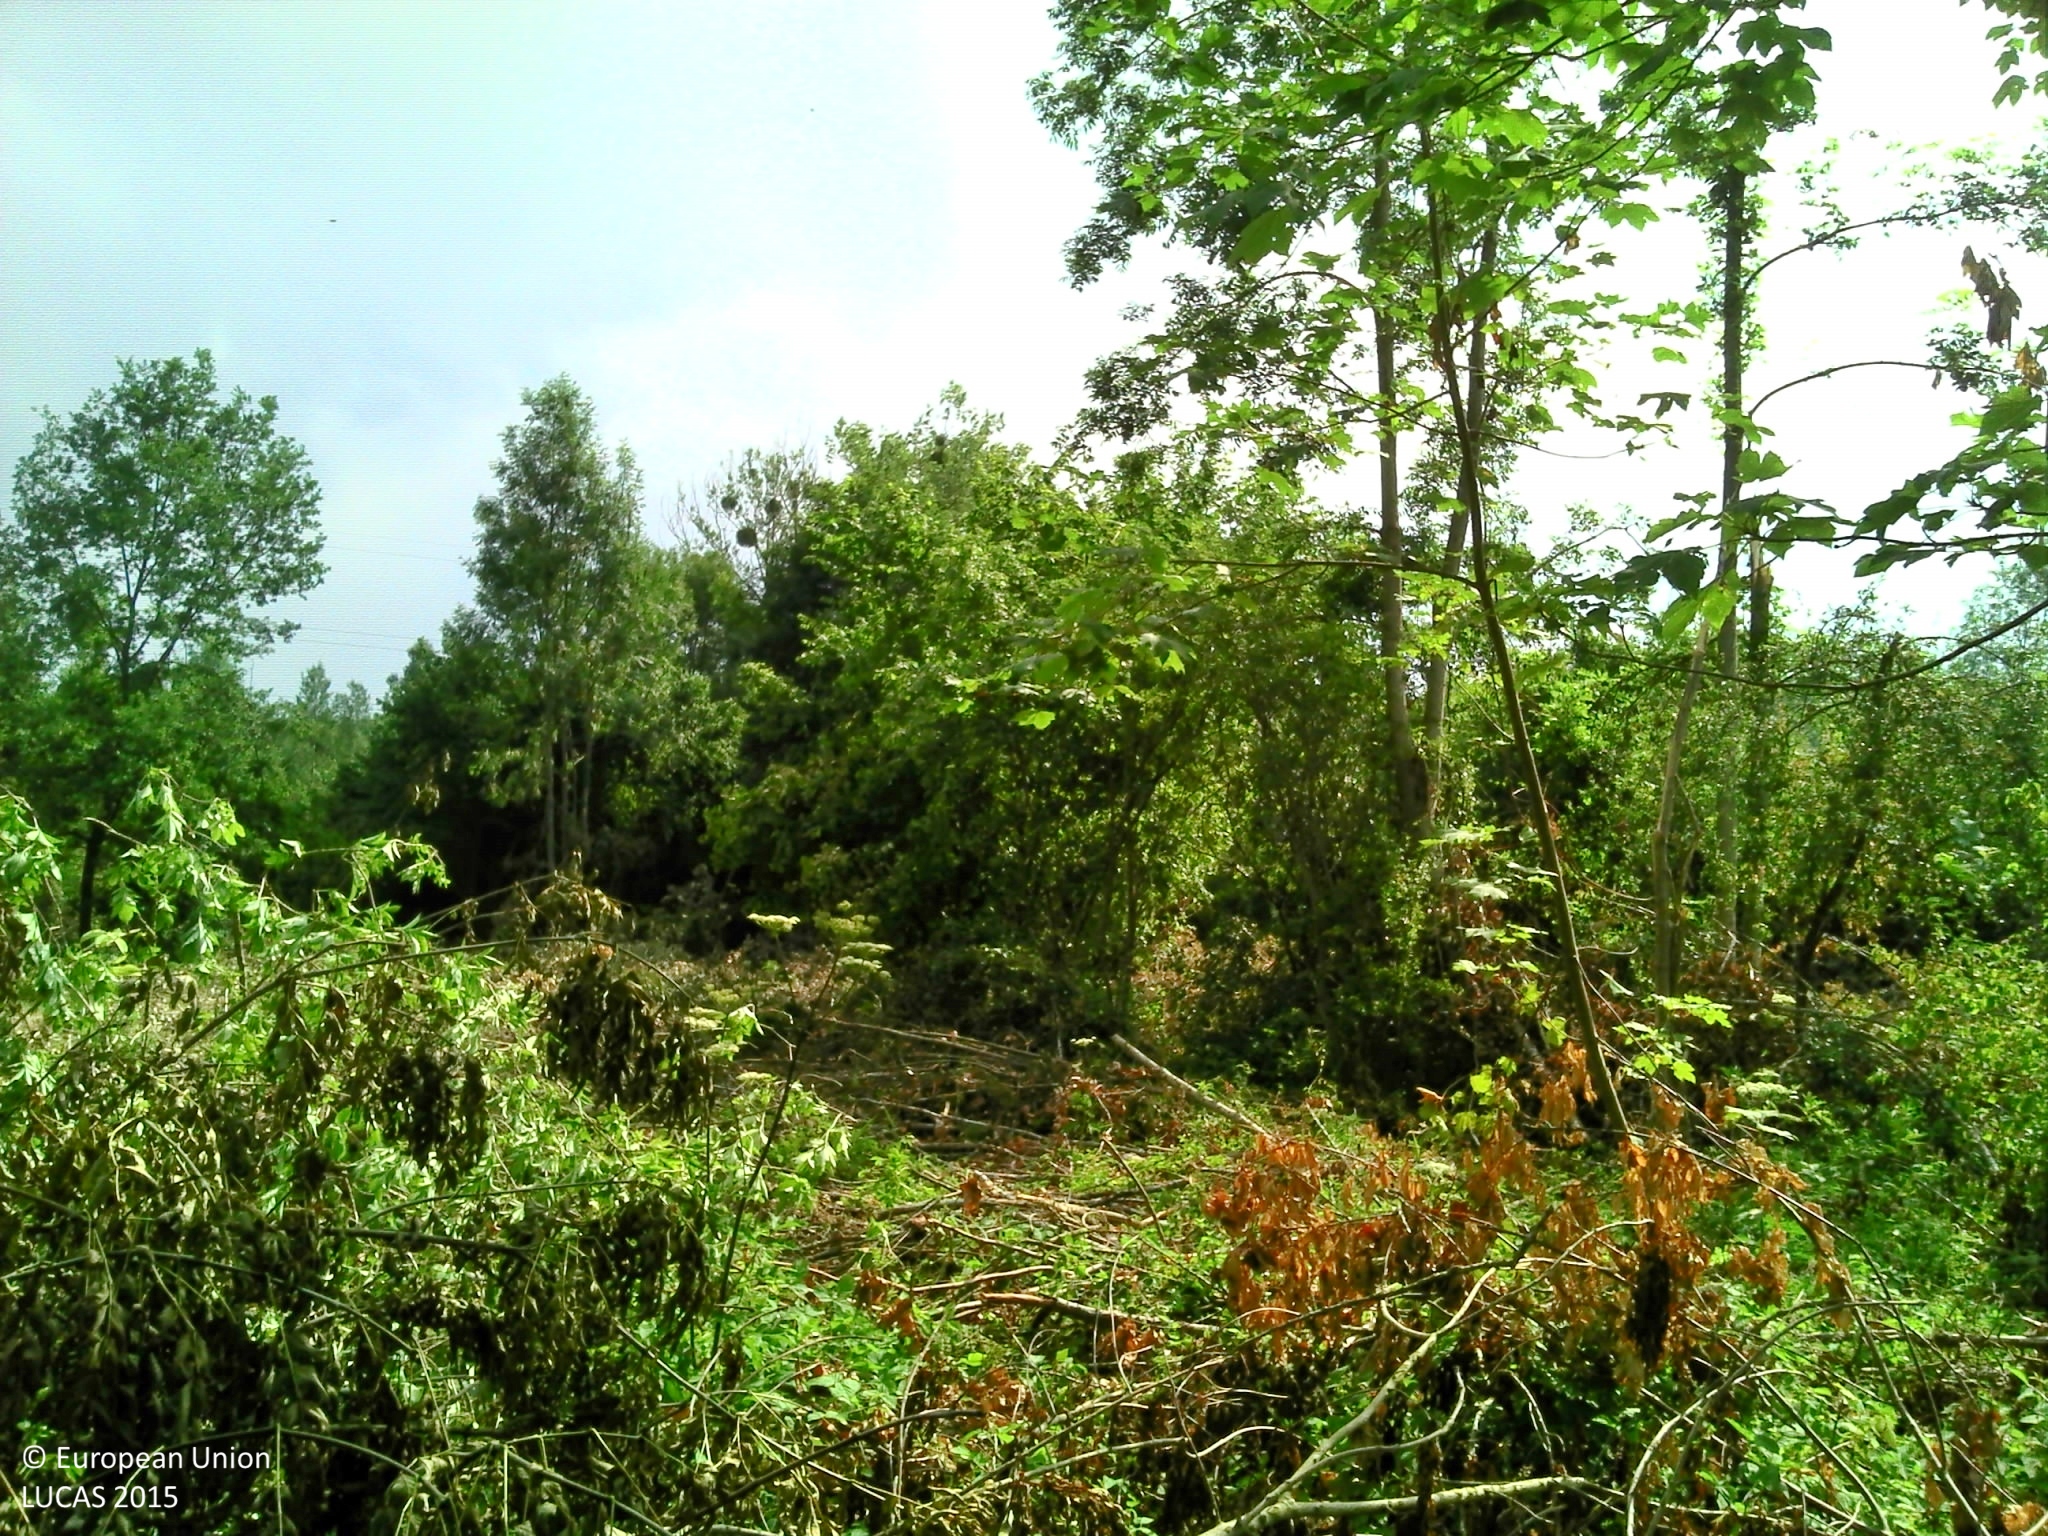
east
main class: Woodland
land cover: Broadleaved woodland
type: mesophytic deciduous forest
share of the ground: > 75 %
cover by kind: broadleaved forest trees 35 %, herbaceous plants 35 %, shrubs 30 %
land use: Forestry
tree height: > 5 m
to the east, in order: Broadleaved woodland; Grassland with sparse tree/shrub cover; Ditches and canals; Common wheat
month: July
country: FR
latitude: 49.3025
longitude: 2.4653
